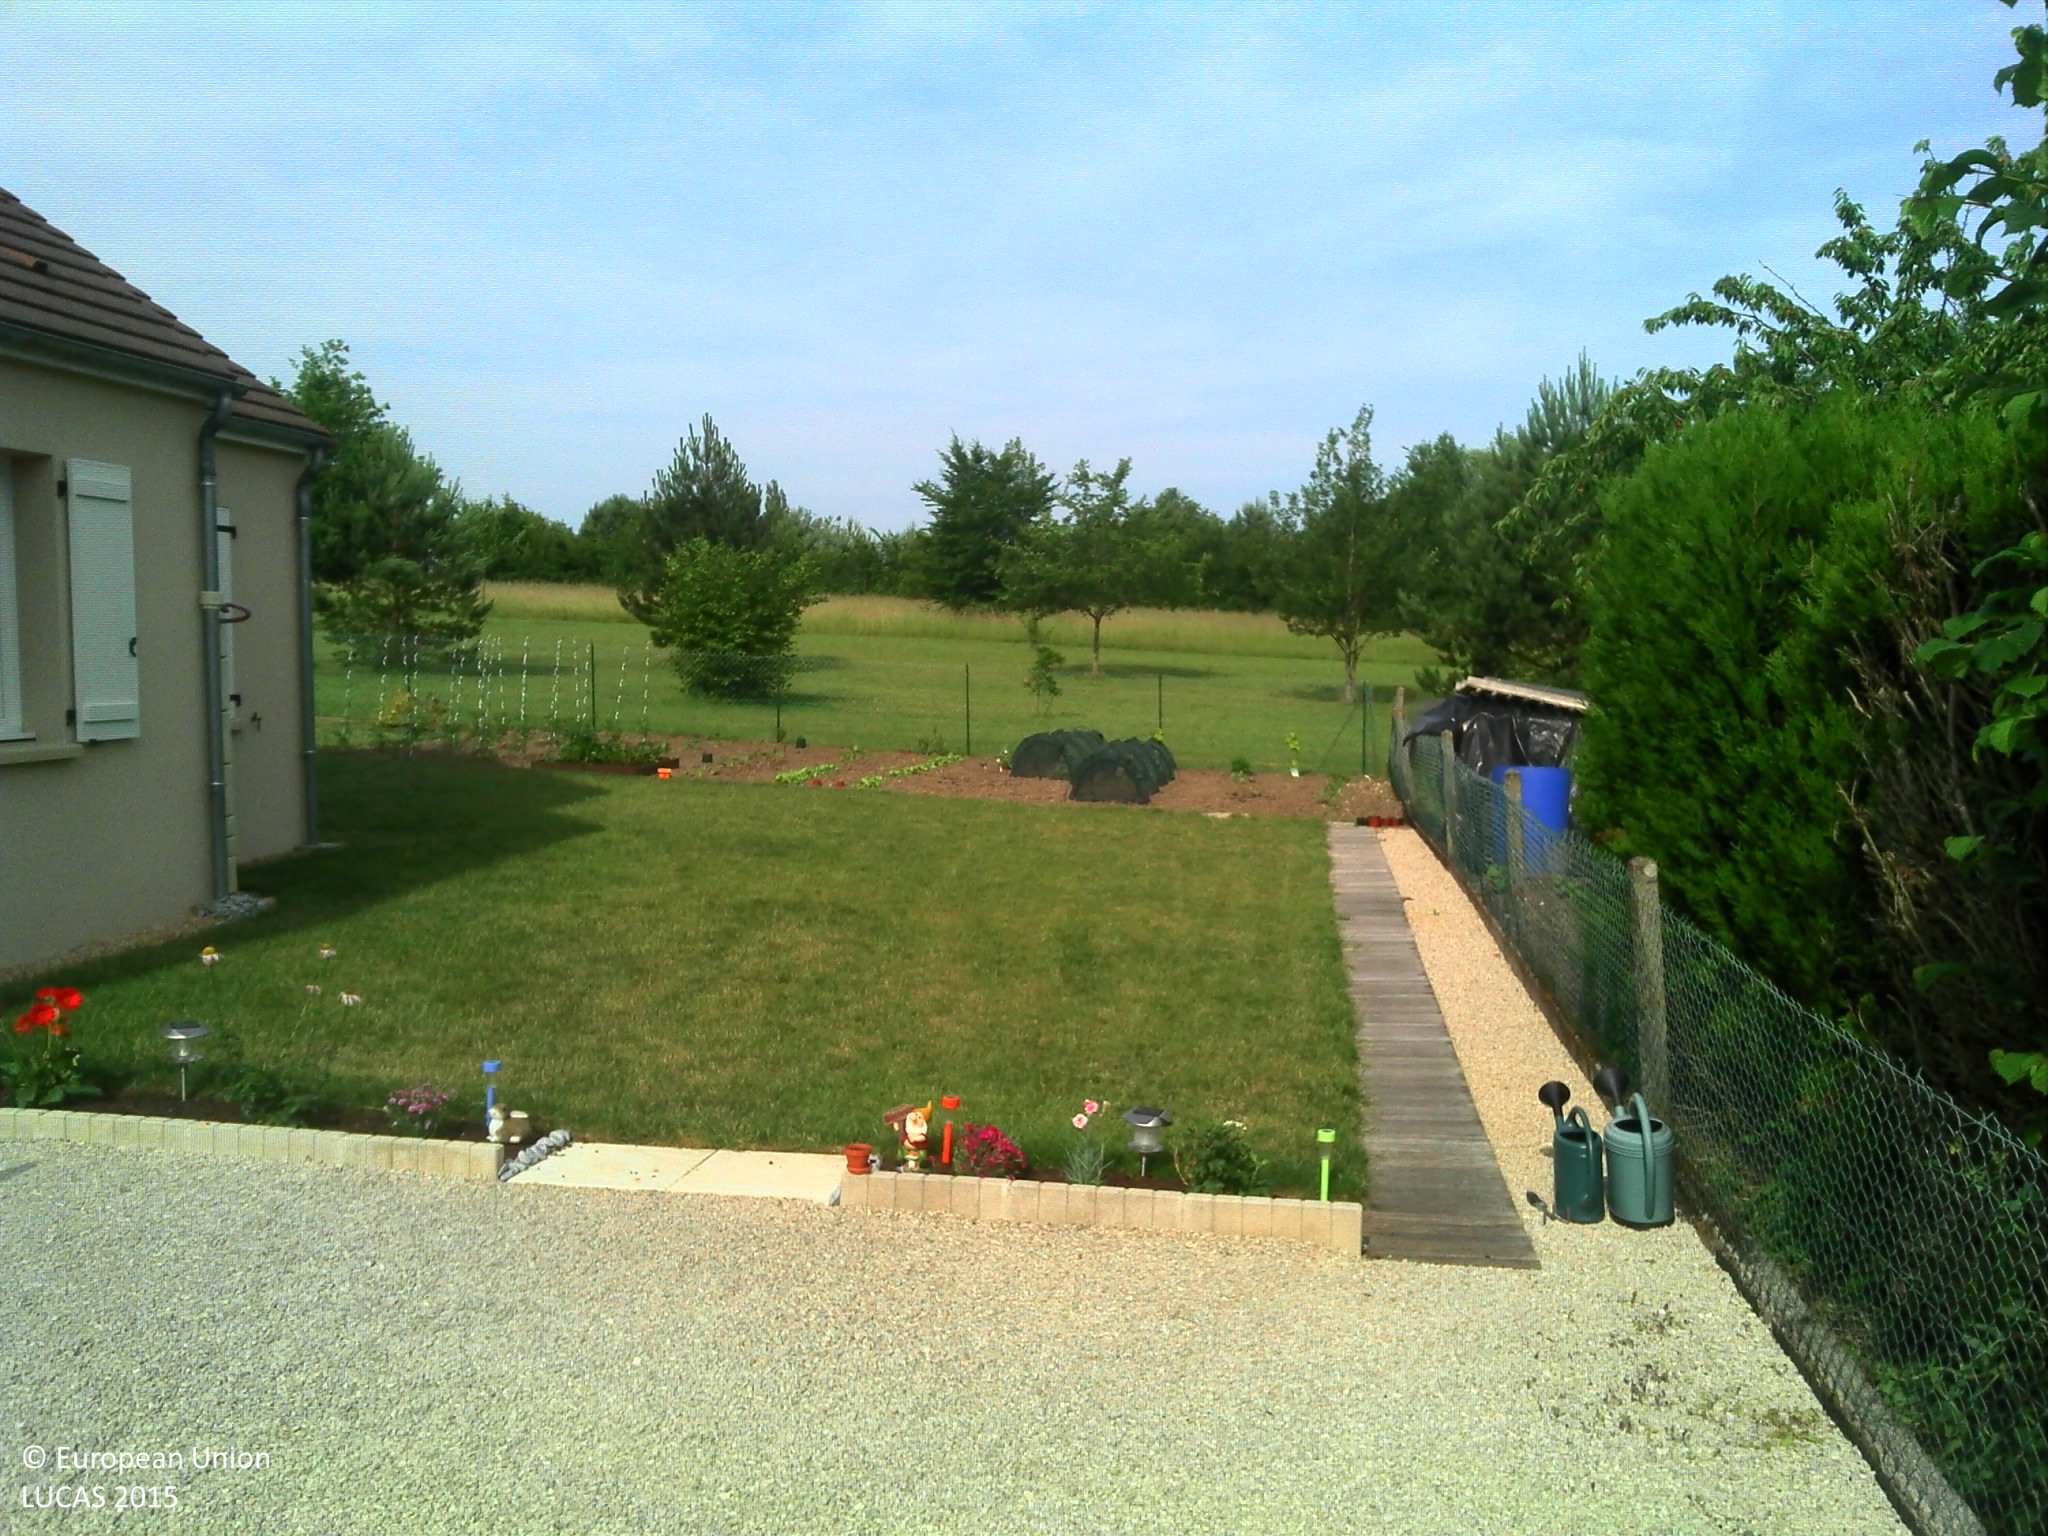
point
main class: Grassland
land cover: Grassland with sparse tree/shrub cover
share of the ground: > 75 %
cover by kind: herbaceous plants 95 %, broadleaved forest trees 5 %
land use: Agriculture (excluding fallow land and kitchen gardens)
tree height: < 5 m
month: June
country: FR
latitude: 47.5265
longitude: 1.4187
